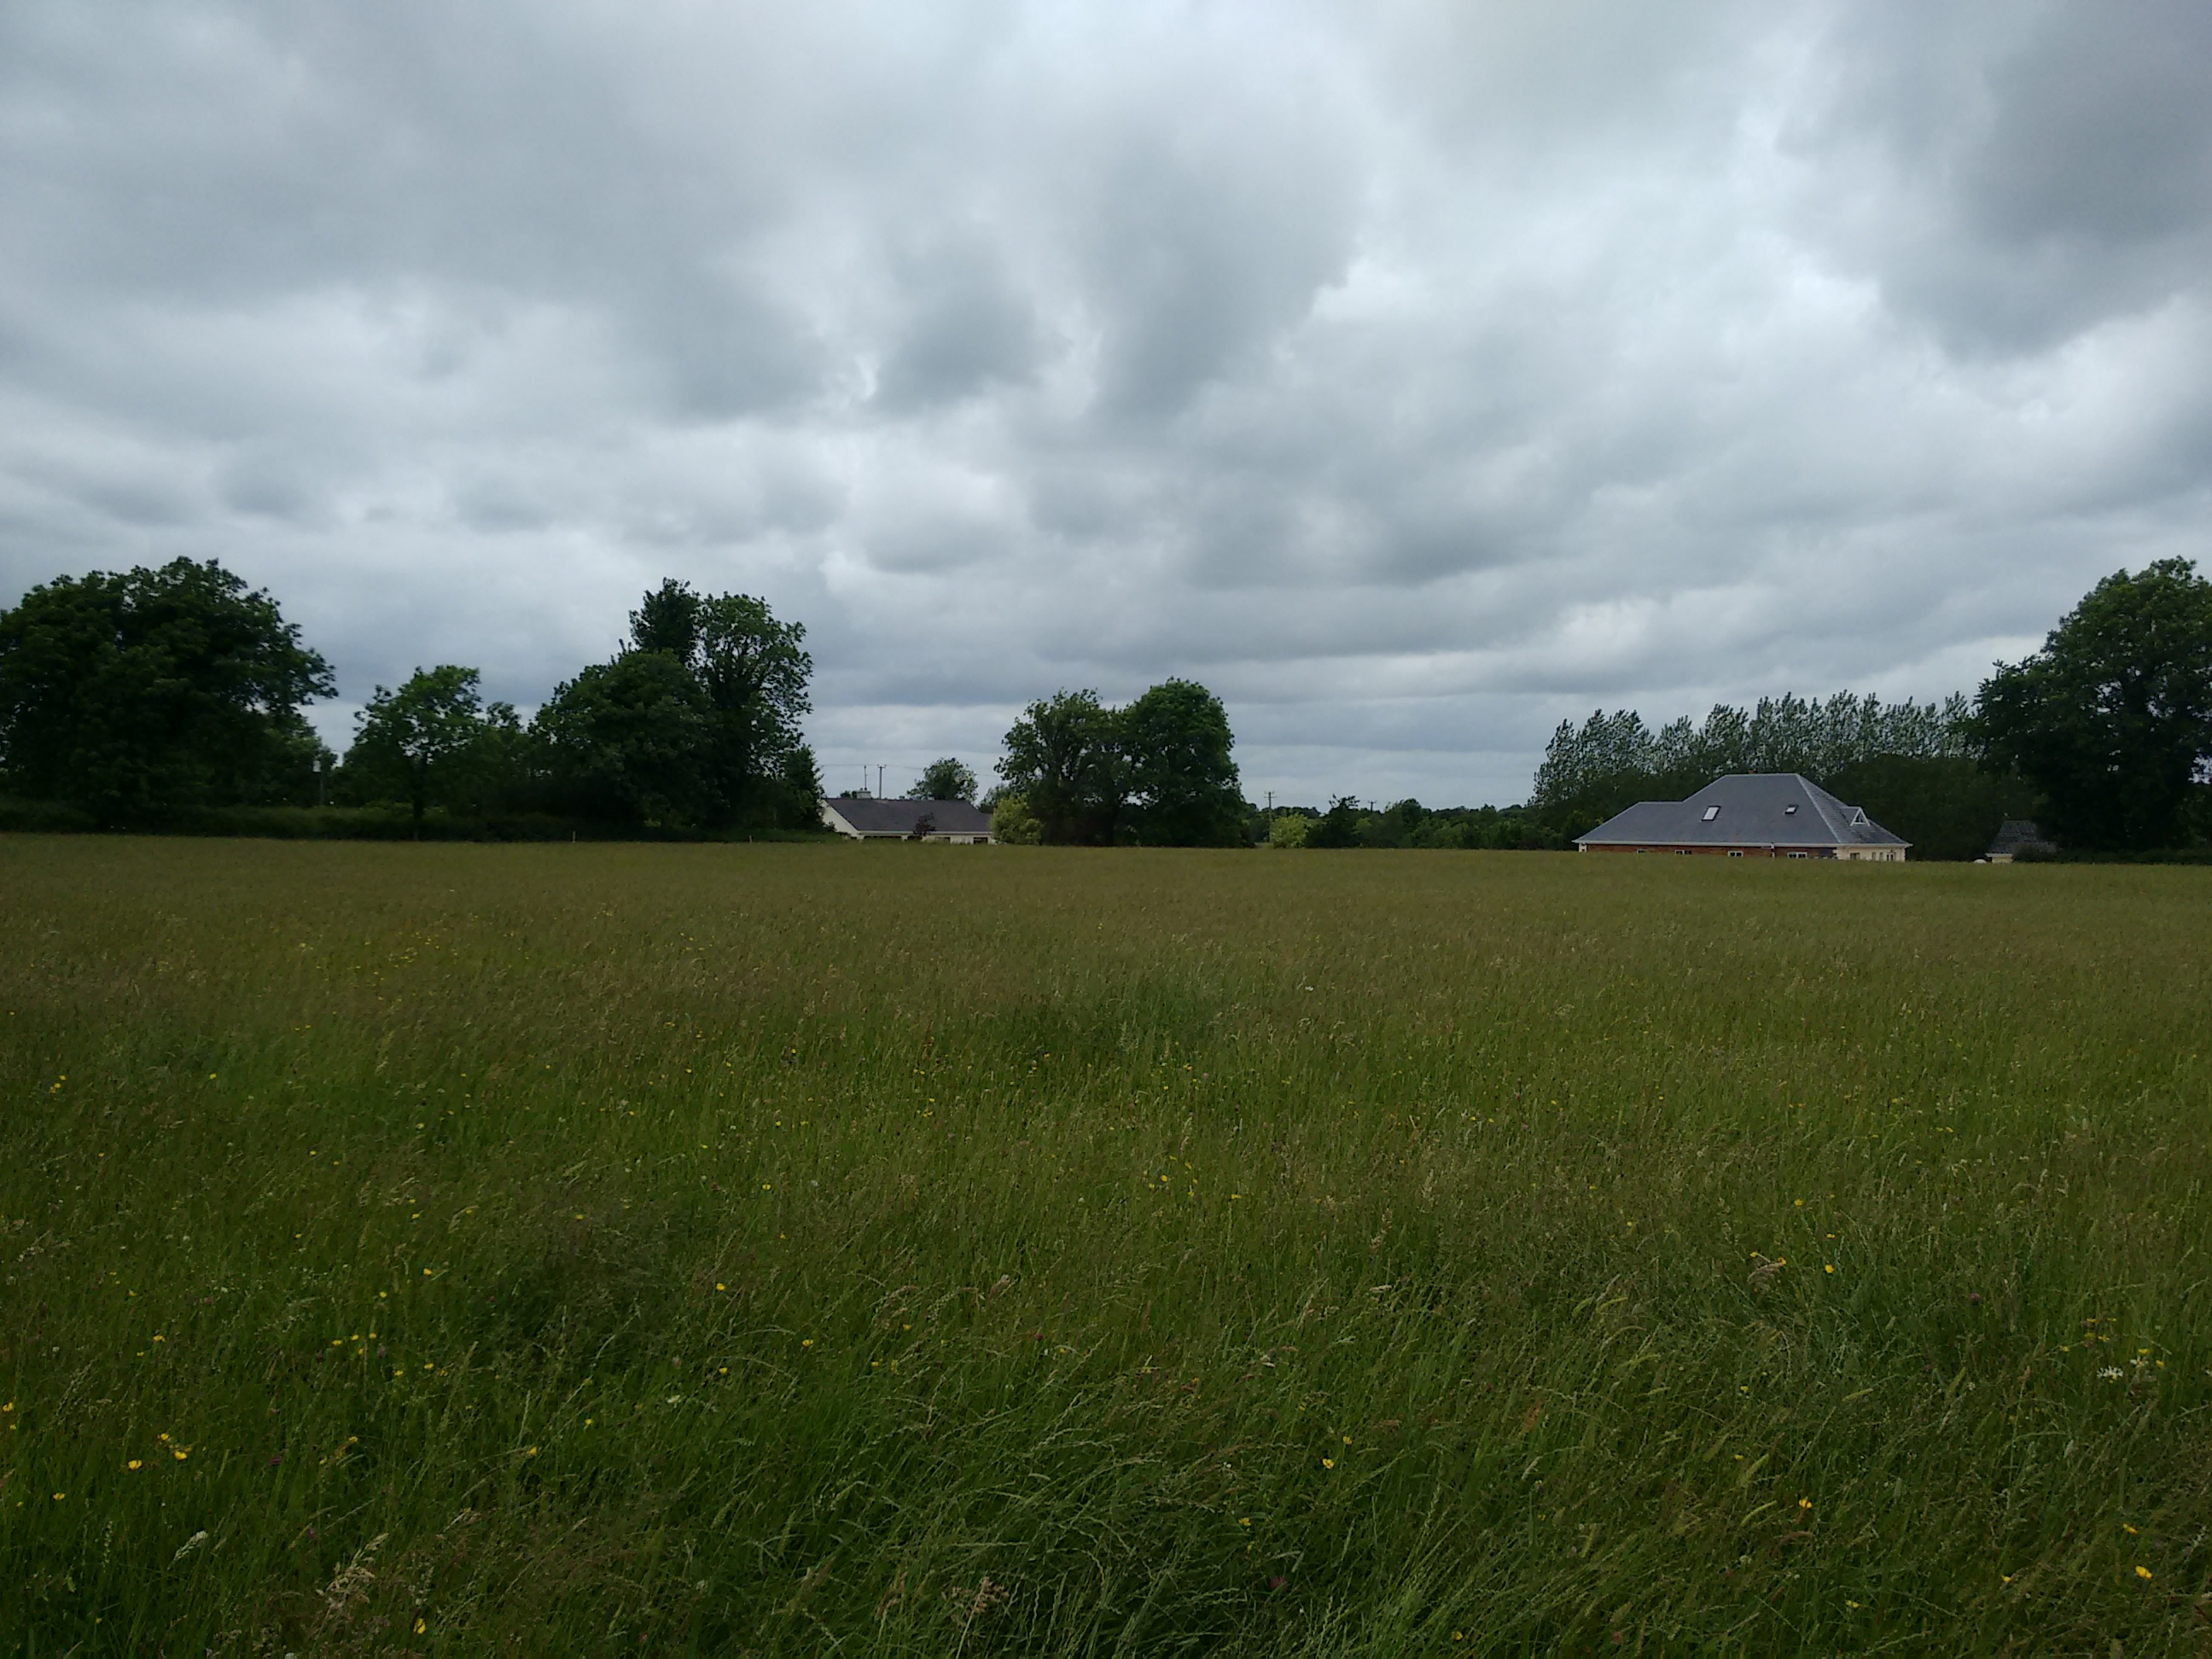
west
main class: Grassland
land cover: Spontaneously vegetated surfaces
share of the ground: > 75 %
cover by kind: herbaceous plants 95 %, shrubs 5 %
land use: Fallow land
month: June
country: IE
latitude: 53.4331
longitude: -7.6690
